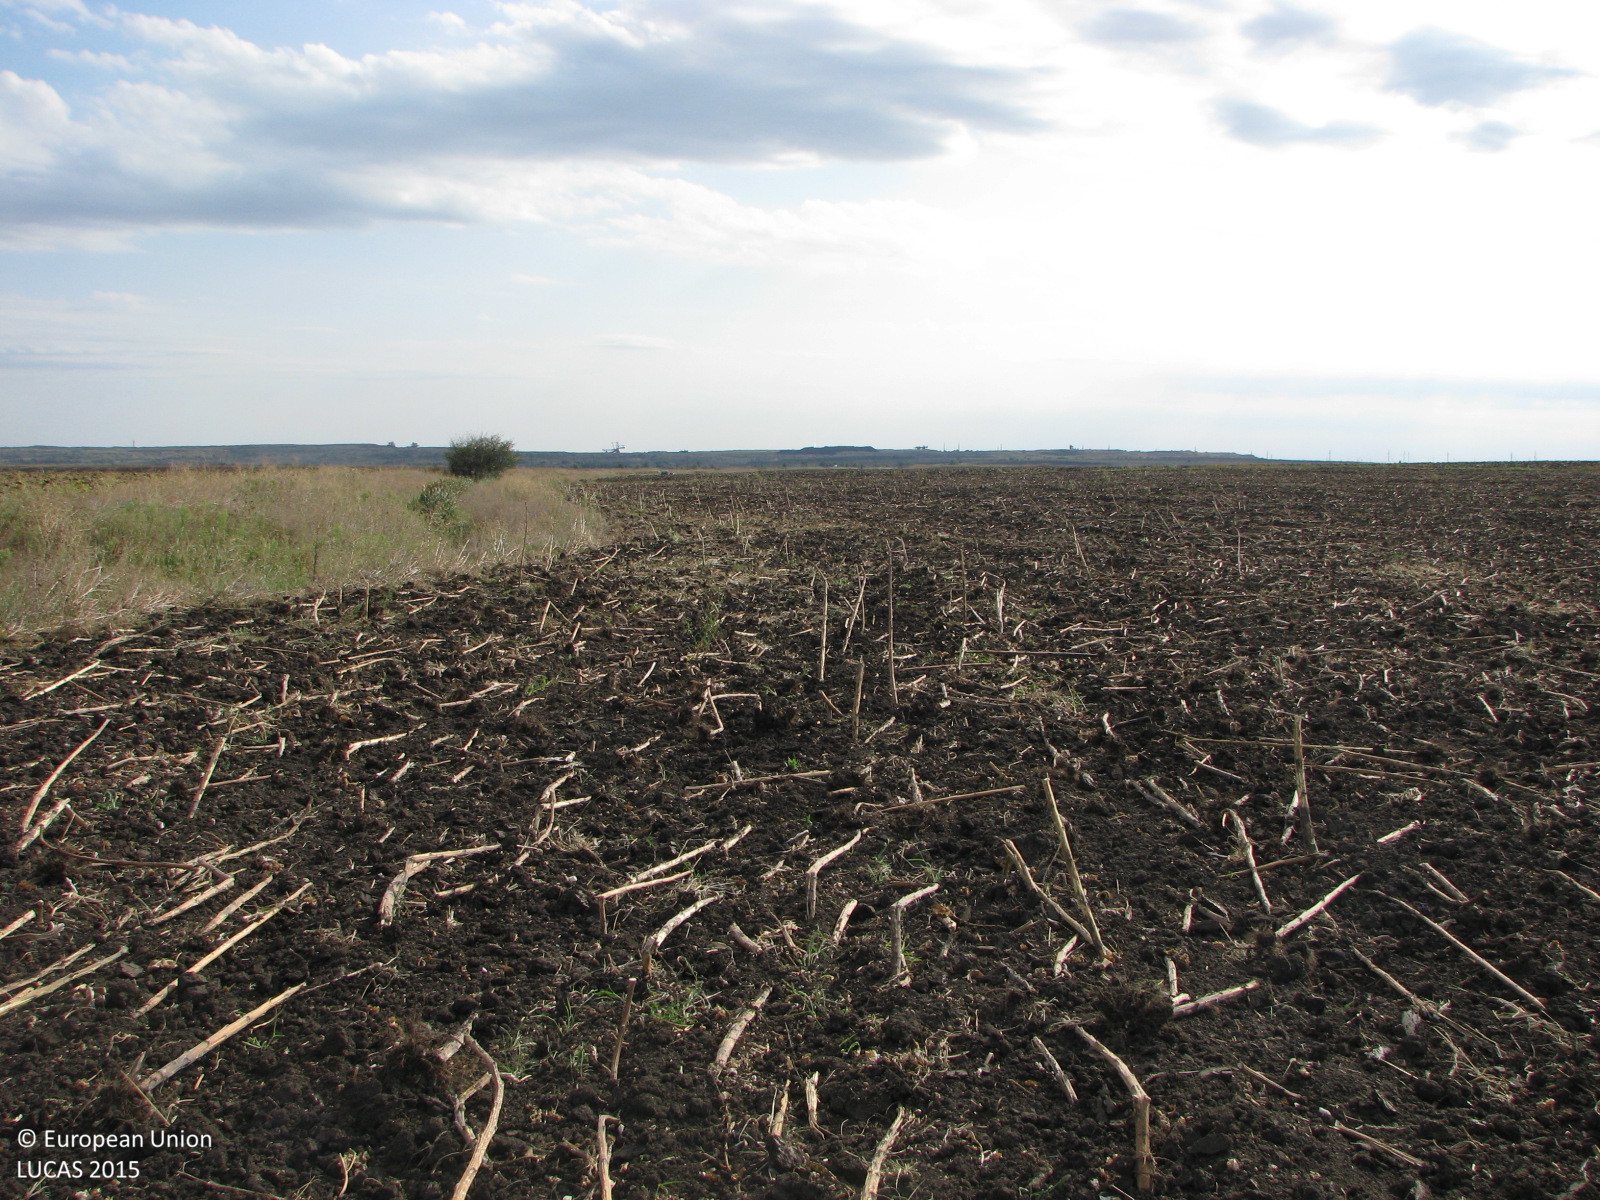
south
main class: Cropland
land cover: Sunflower
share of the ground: < 10 %
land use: Agriculture (excluding fallow land and kitchen gardens)
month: September
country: BG
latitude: 42.3222
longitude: 26.0358
